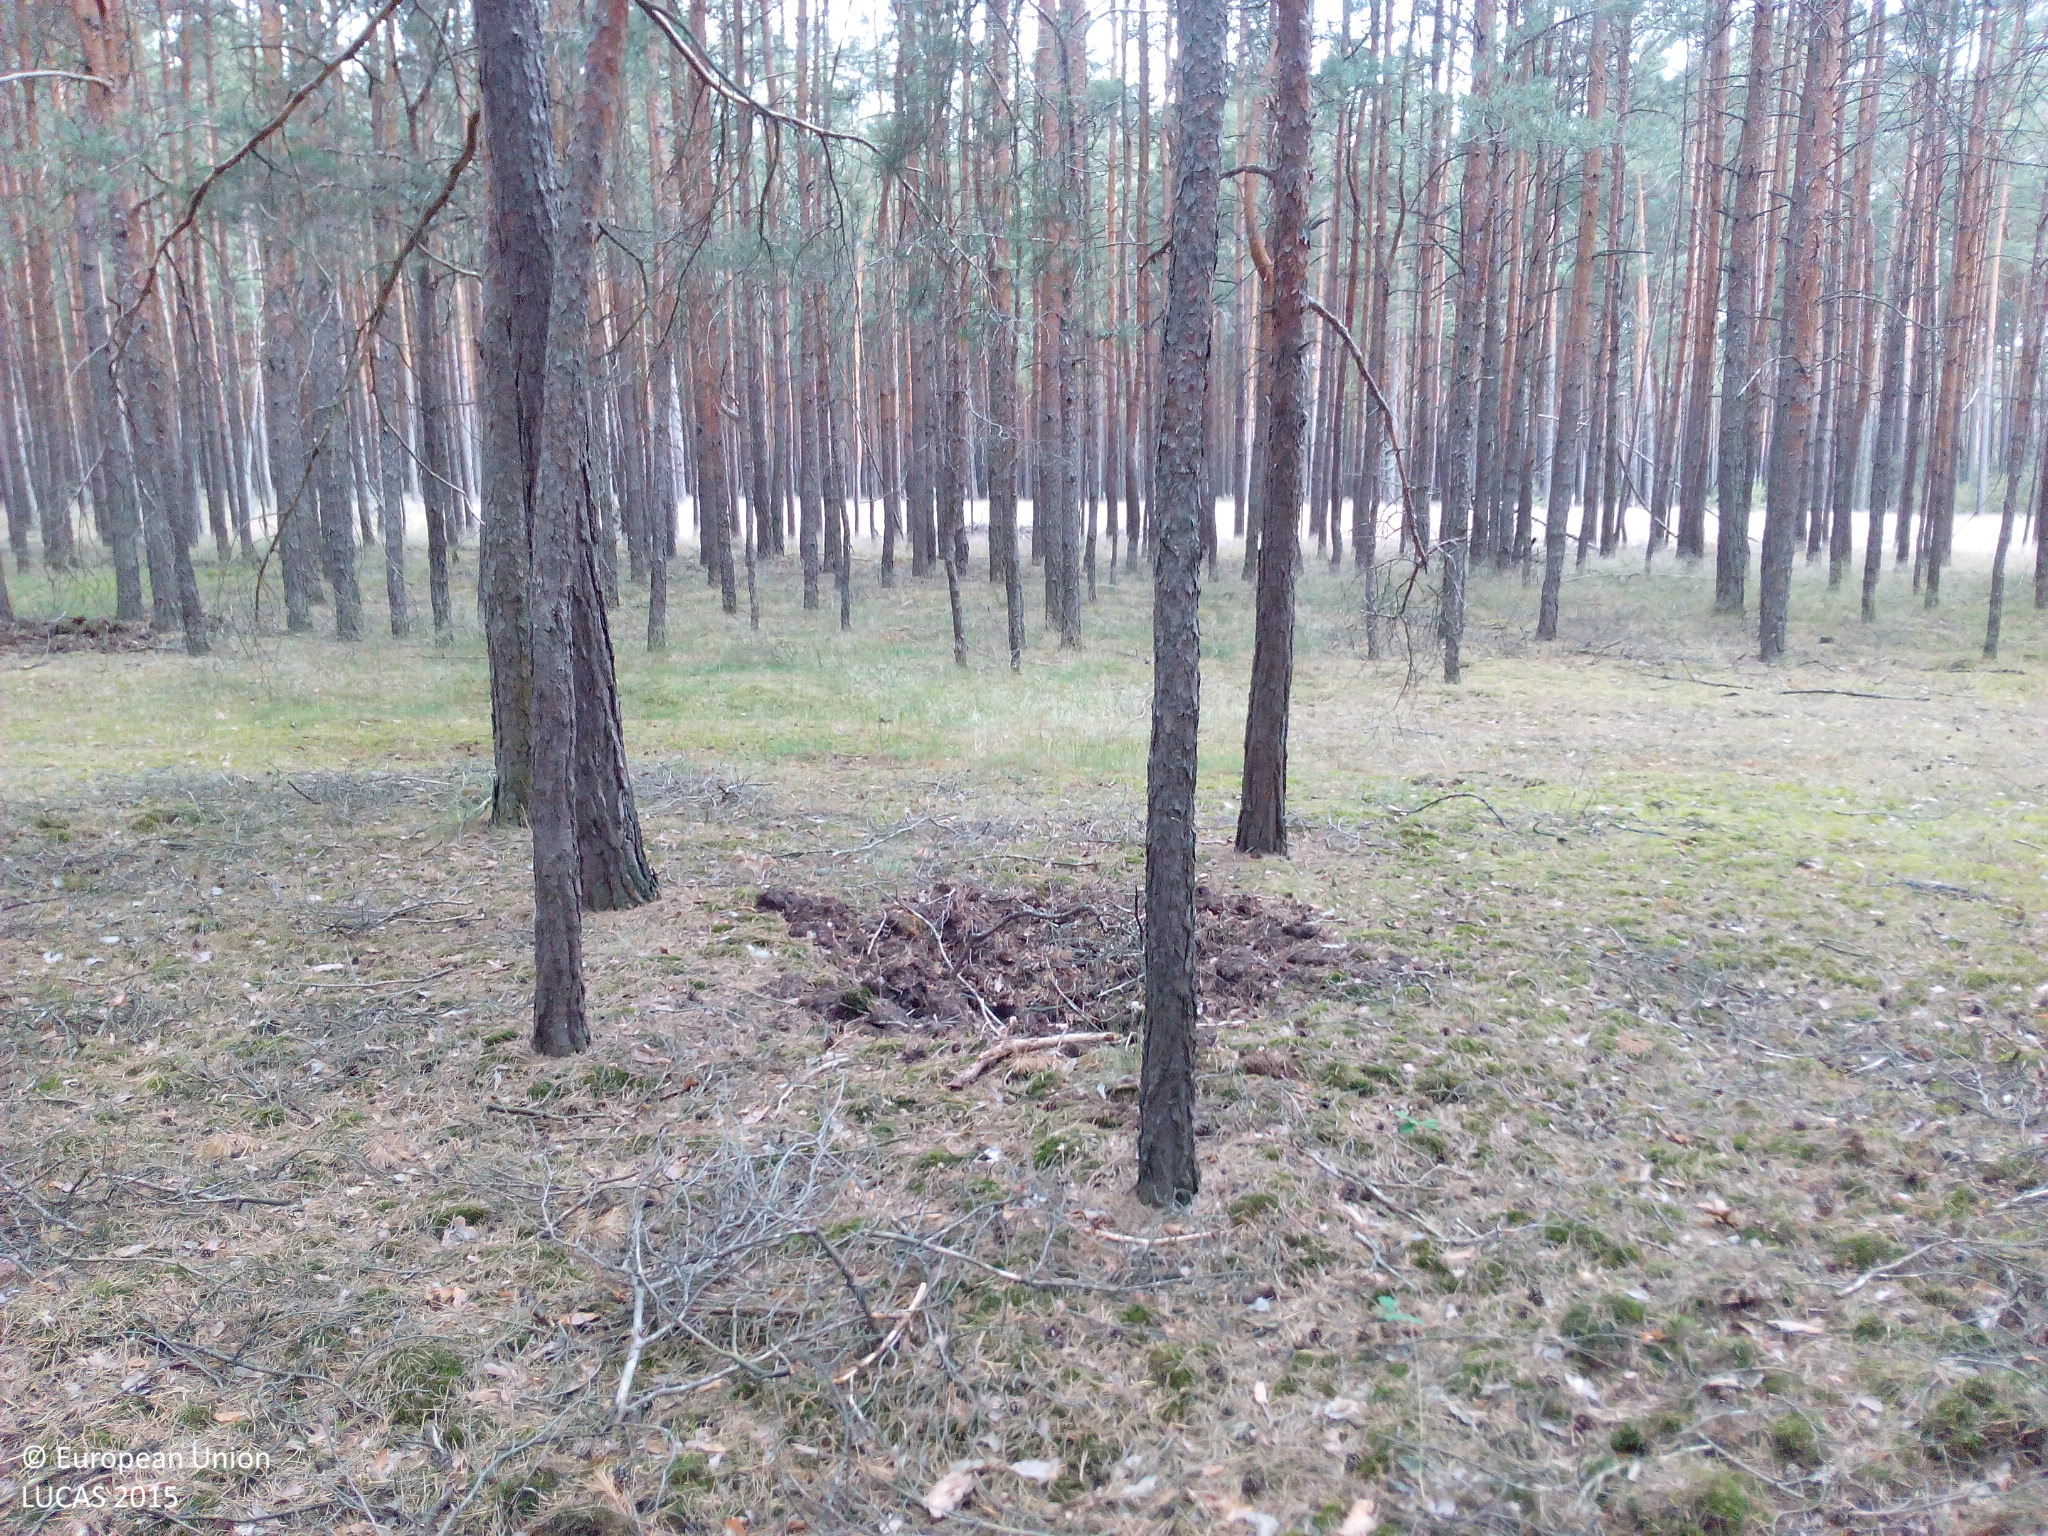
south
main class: Woodland
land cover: Pine dominated coniferous woodland
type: hemiboreal forest and nemoral coniferous forest and mixed broadleaved-coniferous forest
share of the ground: > 75 %
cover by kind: coniferous forest trees 90 %, lichens and mosses 5 %, unconsolidated bare surface 5 %
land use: Forestry
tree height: > 5 m
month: June
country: DE
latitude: 52.2809
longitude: 12.4182
